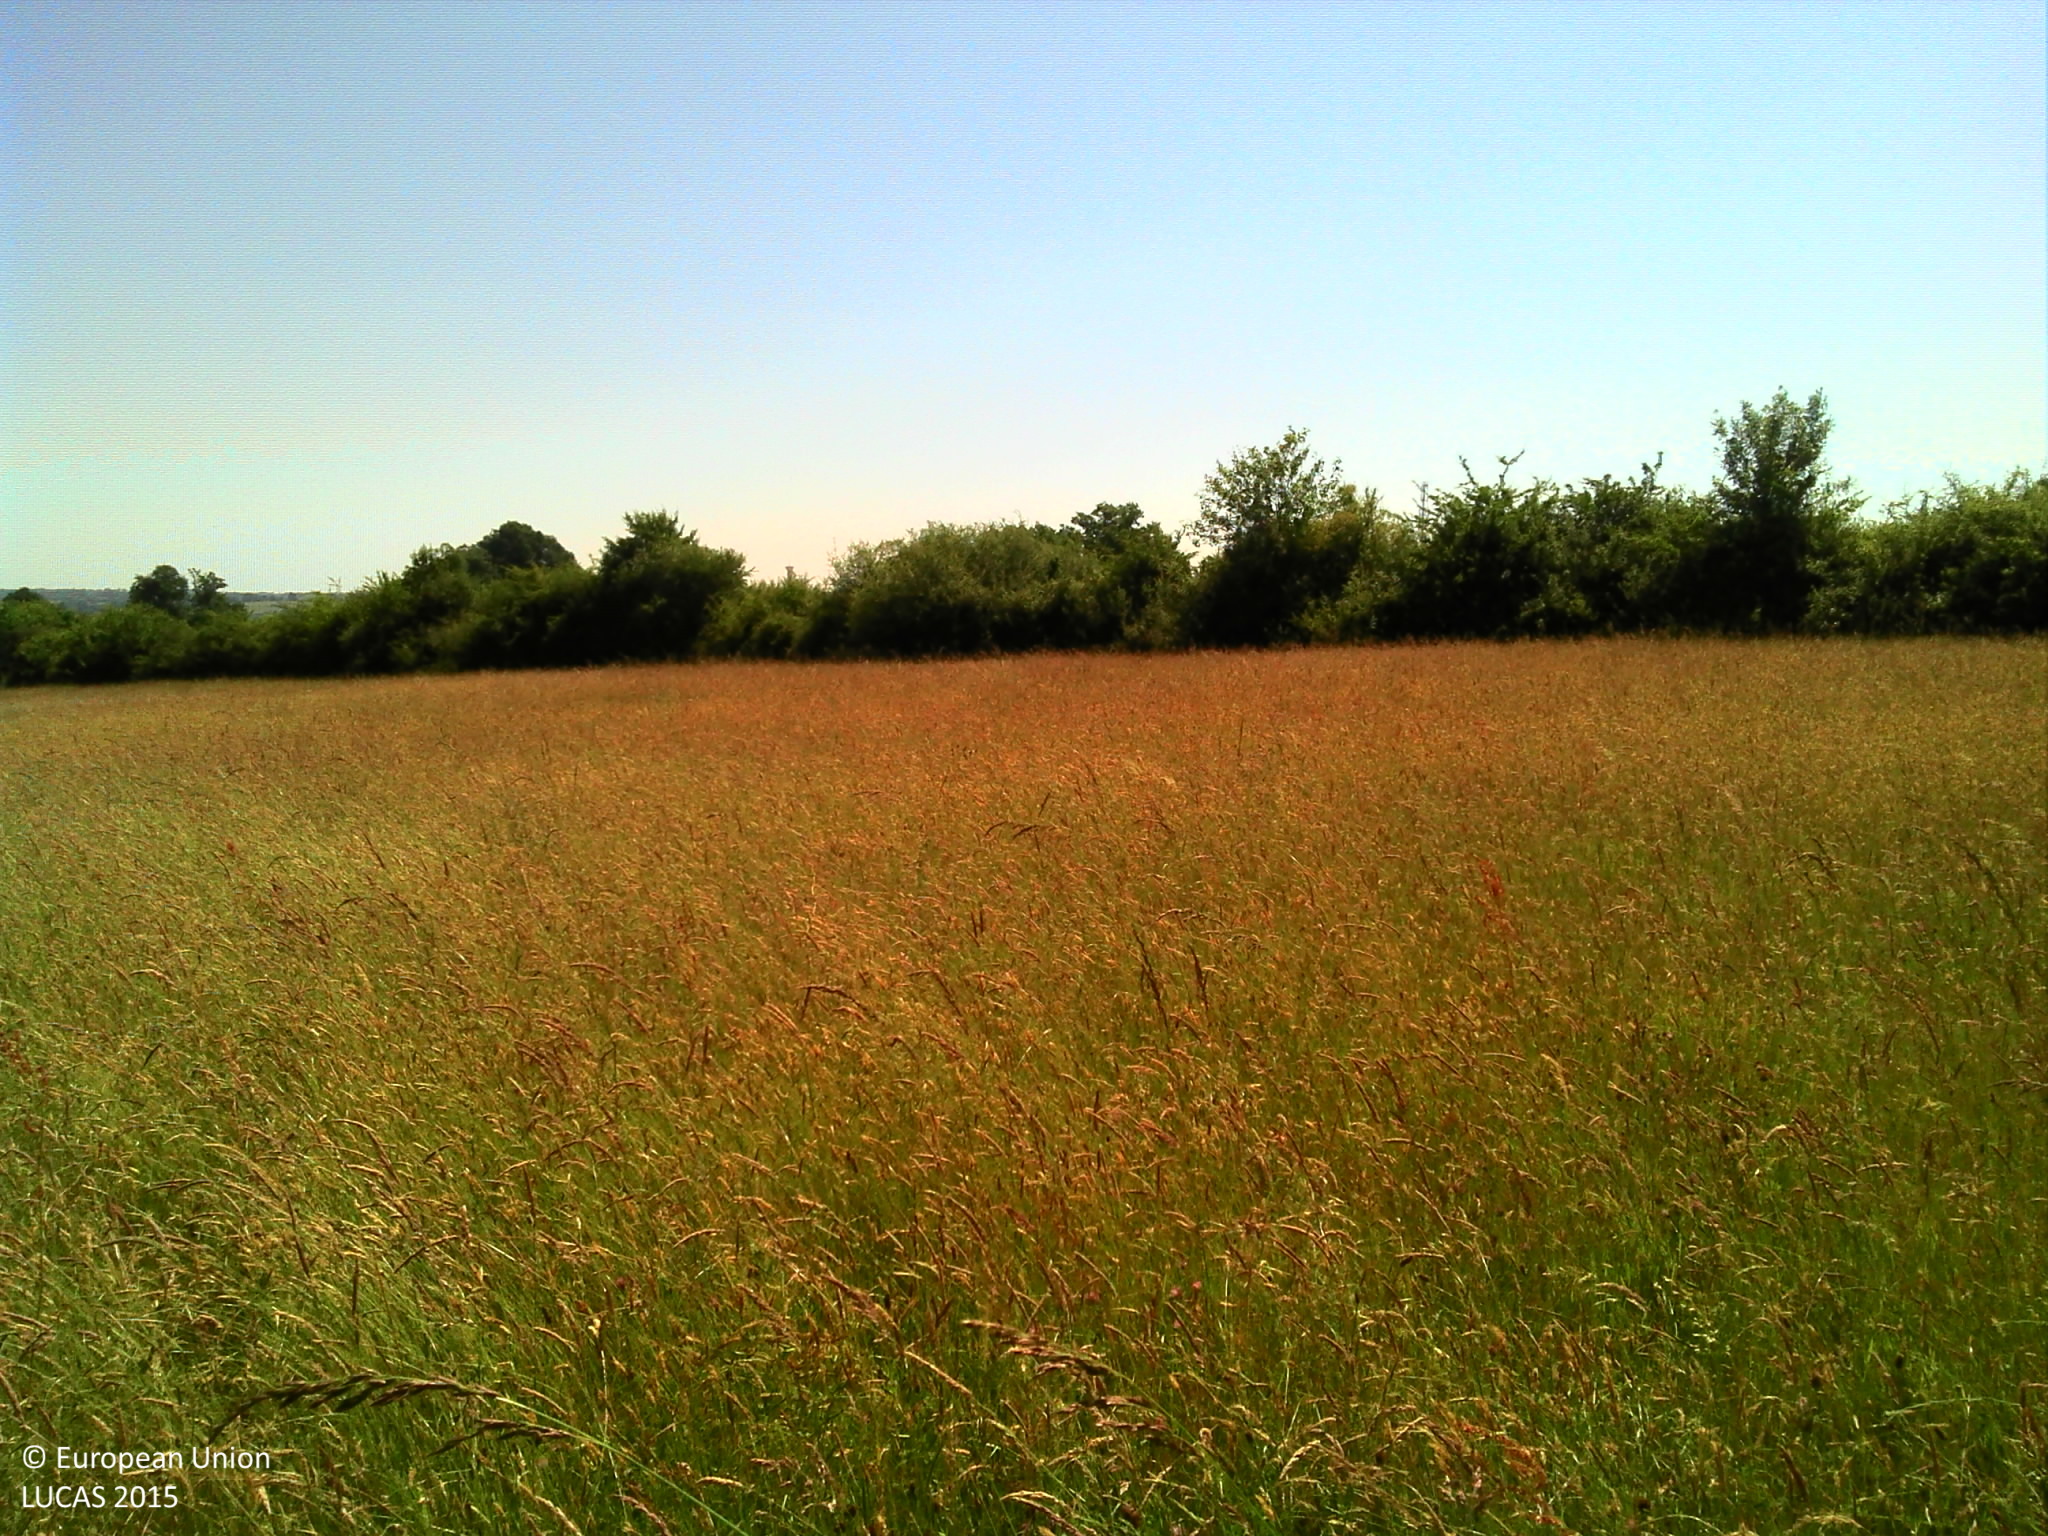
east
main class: Grassland
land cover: Grassland without tree/shrub cover
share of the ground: > 75 %
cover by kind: herbaceous plants 100 %
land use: Agriculture (excluding fallow land and kitchen gardens)
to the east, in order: Grassland without tree/shrub cover; Electric lines; Grassland without tree/shrub cover; Abandoned hedges; Fences; Spontaneously vegetated surfaces; Abandoned hedges; Fences; Grassland without tree/shrub cover; Fences; Abandoned hedges; Grassland without tree/shrub cover
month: June
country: FR
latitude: 46.0310
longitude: 0.6448
